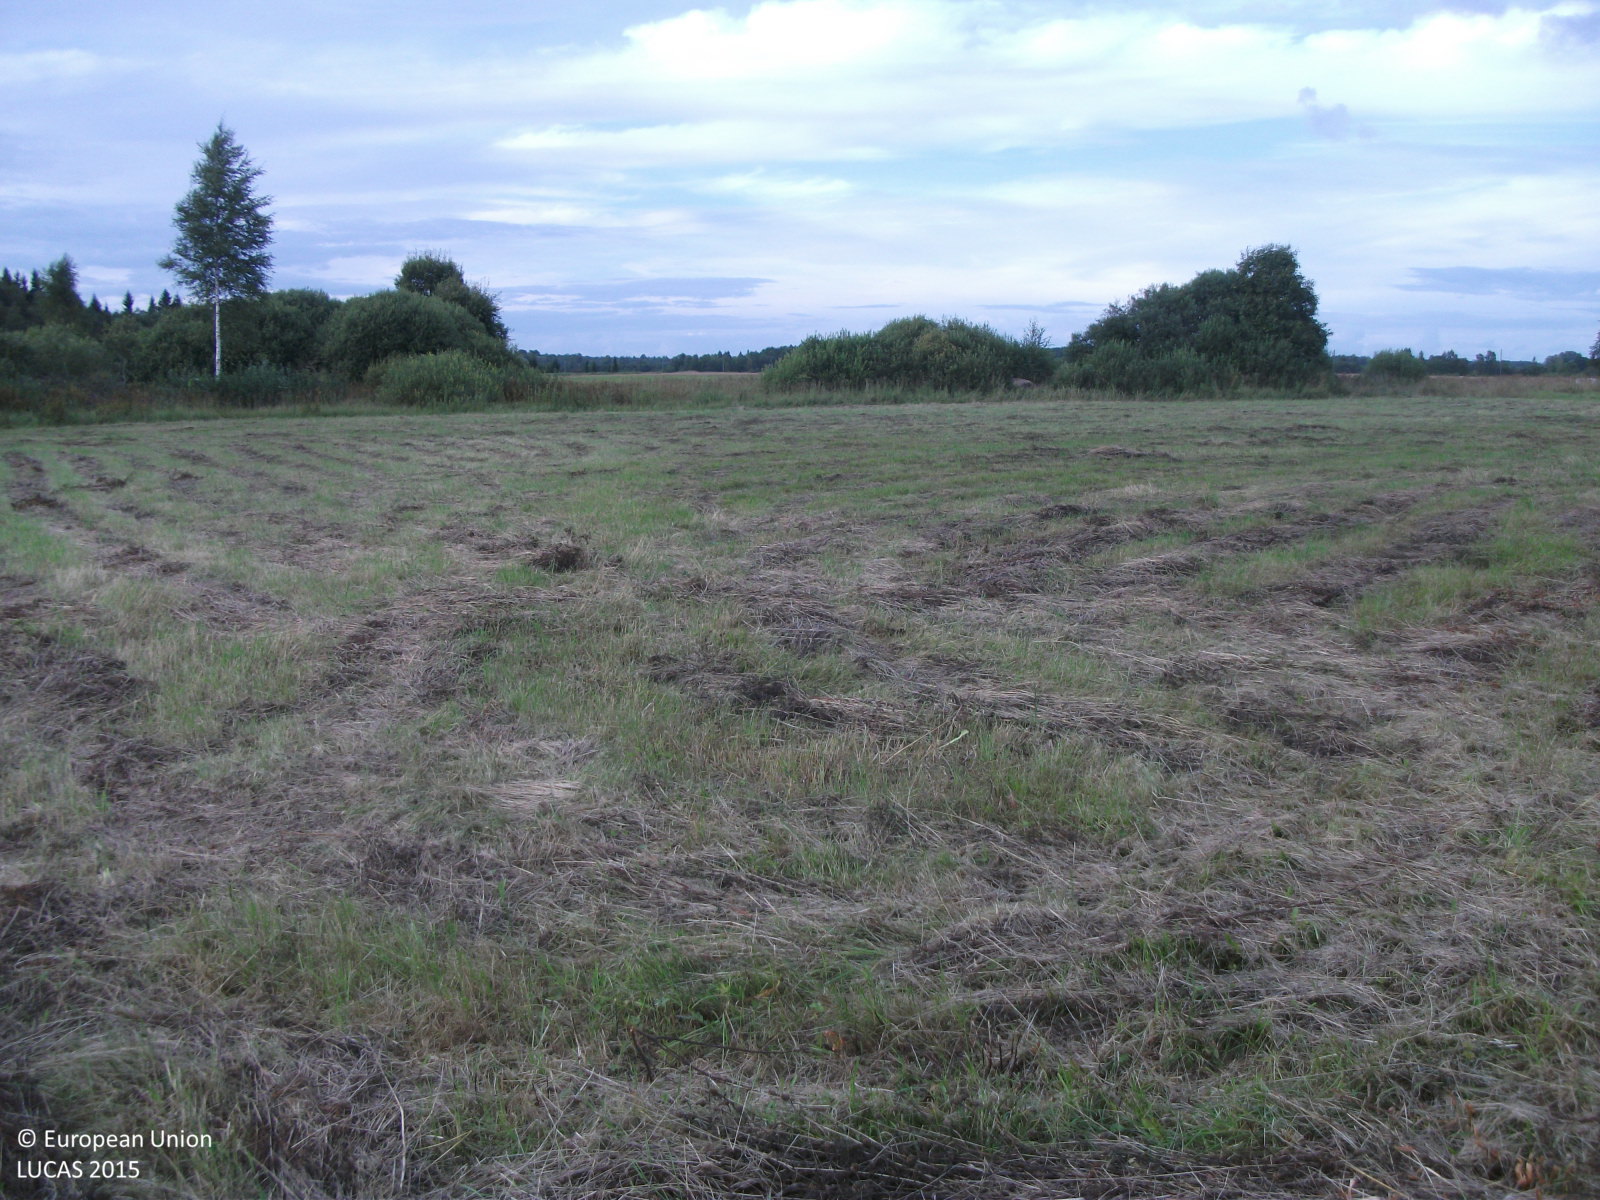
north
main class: Grassland
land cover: Grassland without tree/shrub cover
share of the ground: > 75 %
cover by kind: herbaceous plants 100 %
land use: Agriculture (excluding fallow land and kitchen gardens)
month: September
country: LV
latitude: 57.6547
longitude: 24.7595
